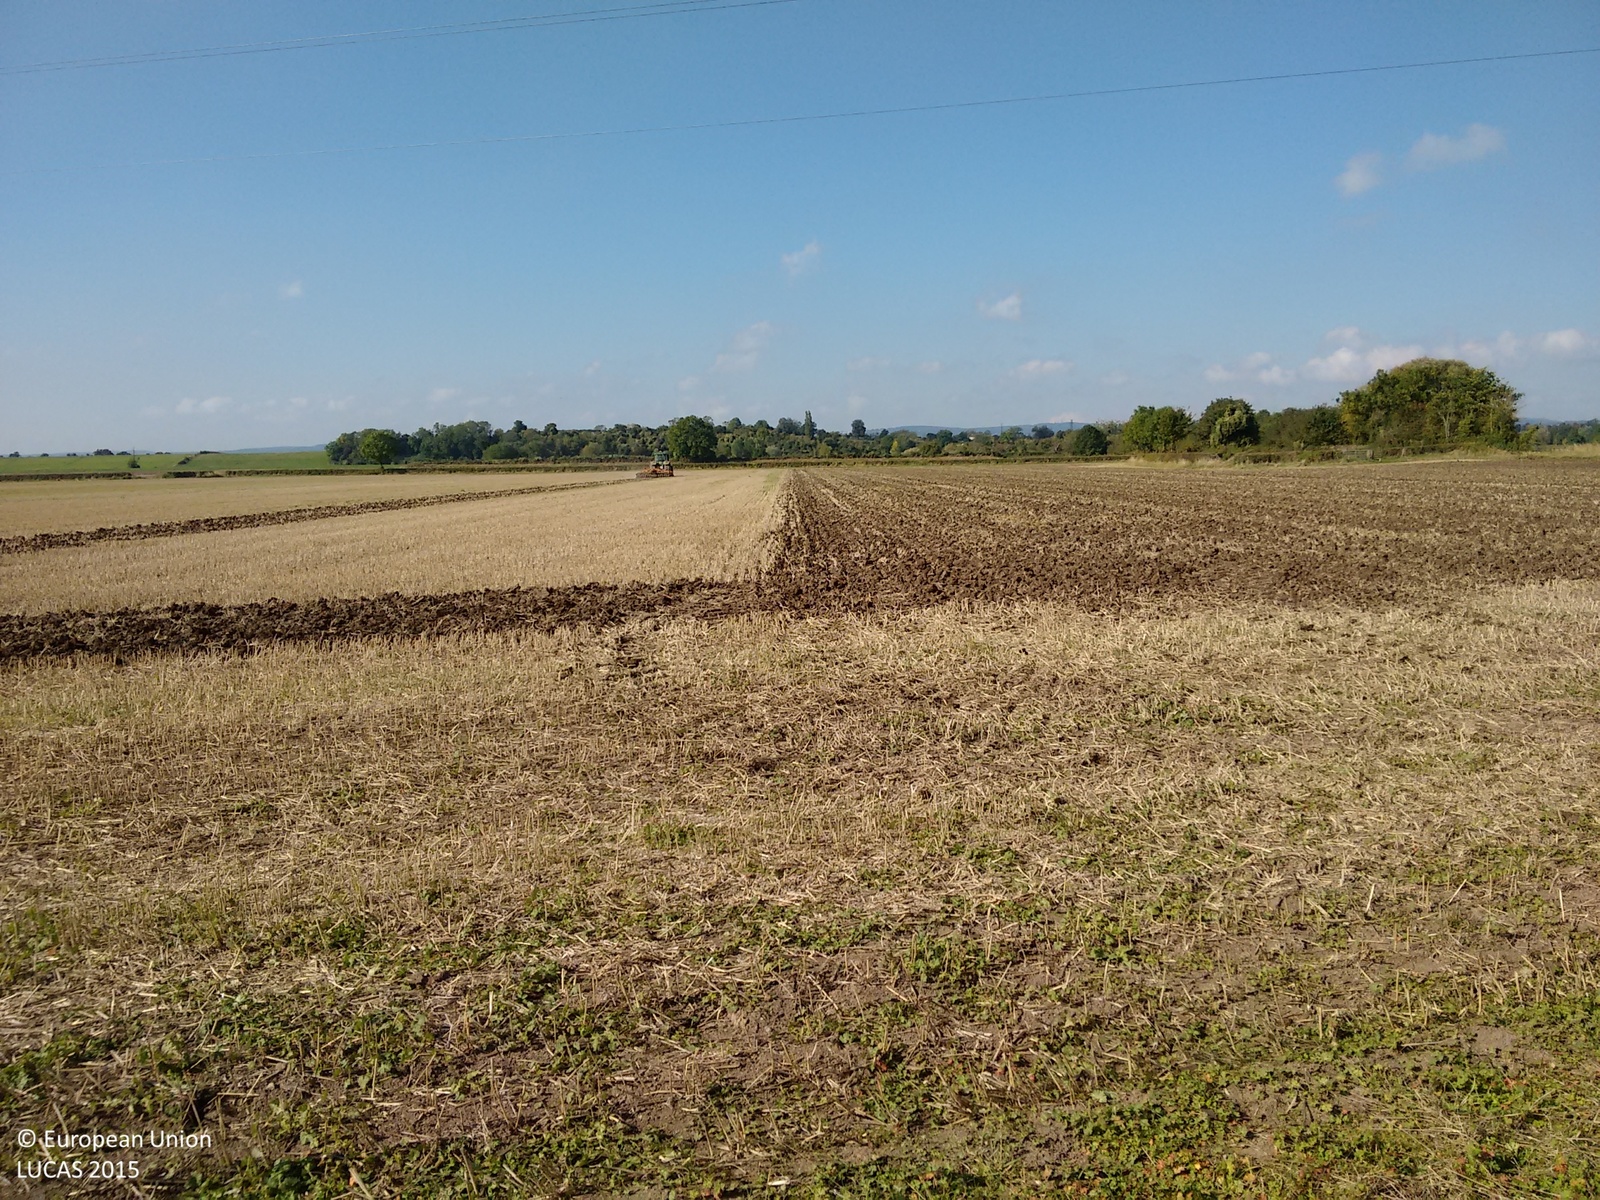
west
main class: Grassland
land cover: Grassland without tree/shrub cover
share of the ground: > 75 %
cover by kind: herbaceous plants 100 %
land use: Agriculture (excluding fallow land and kitchen gardens)
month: September
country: GB
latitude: 51.8203
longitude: -2.3520
